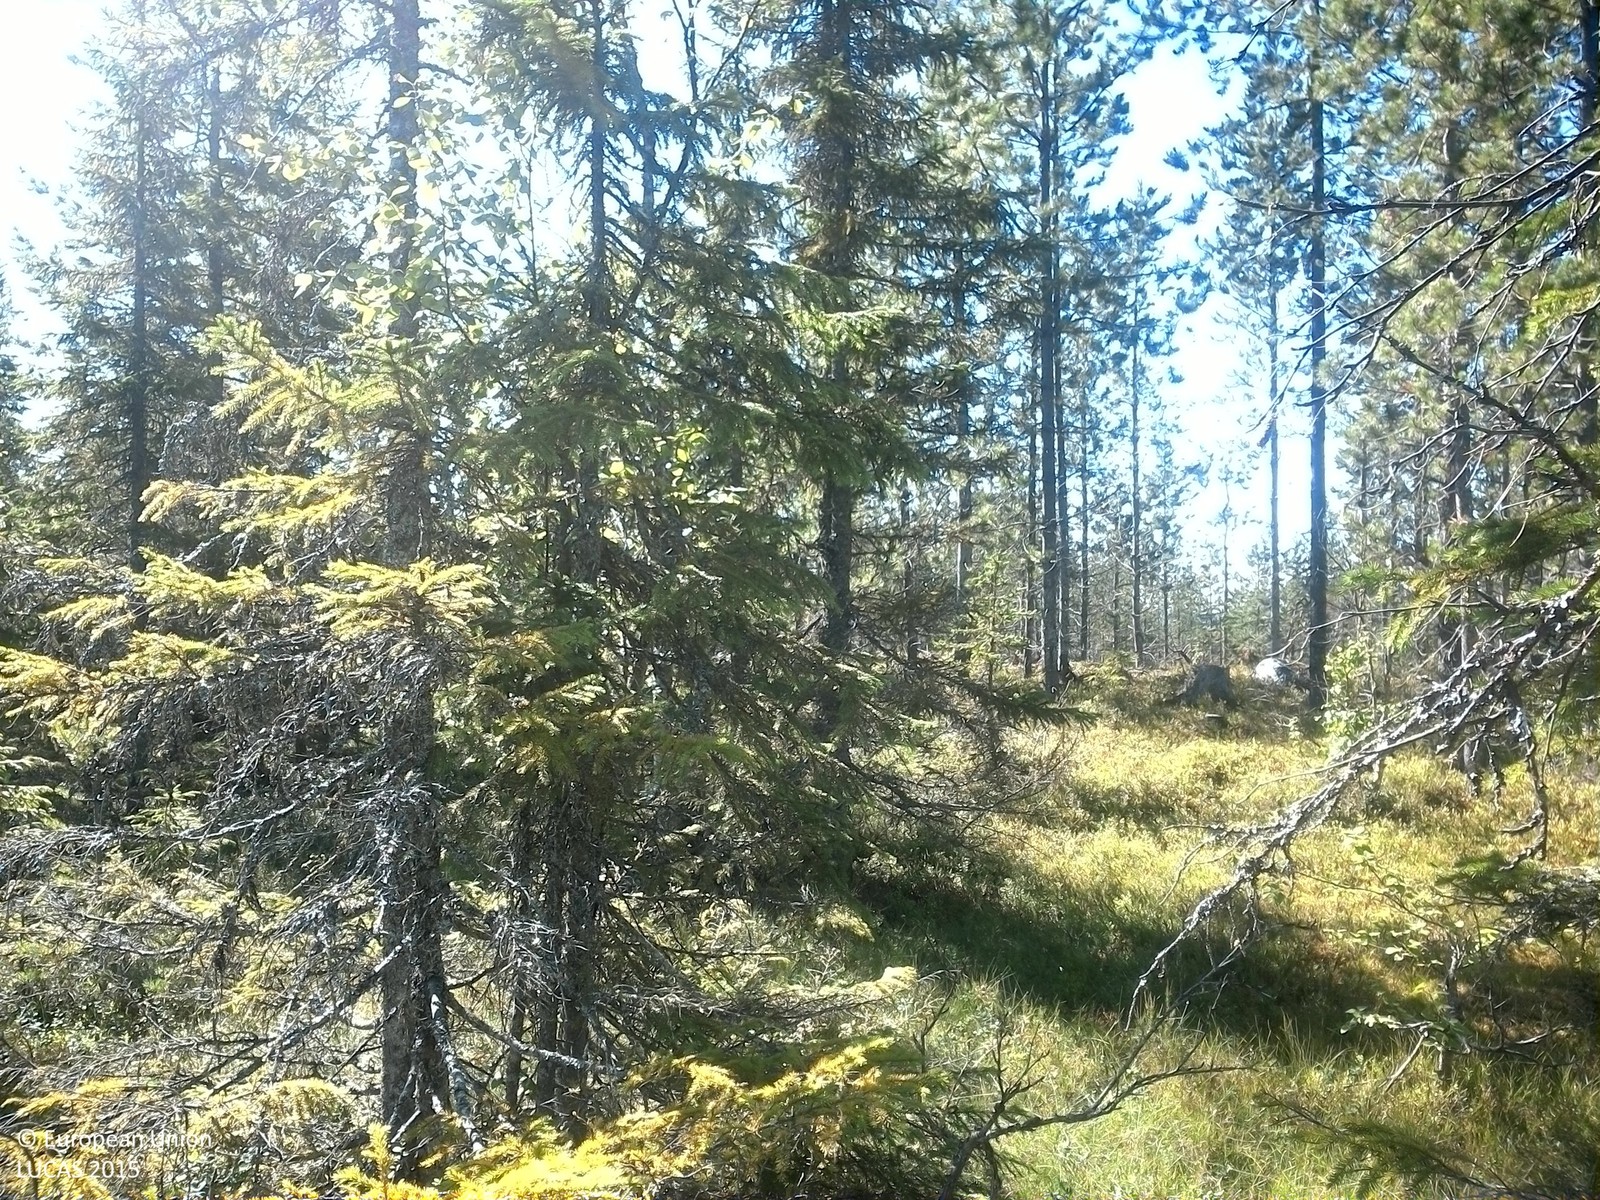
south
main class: Woodland
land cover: Spruce dominated mixed woodland
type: boreal forest
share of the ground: 25 - 50 %
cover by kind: shrubs 40 %, coniferous forest trees 20 %, lichens and mosses 20 %, broadleaved forest trees 10 %, herbaceous plants 10 %
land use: Semi-natural and natural areas not in use
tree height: > 5 m
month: August
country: SE
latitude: 62.8178
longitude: 17.2575
